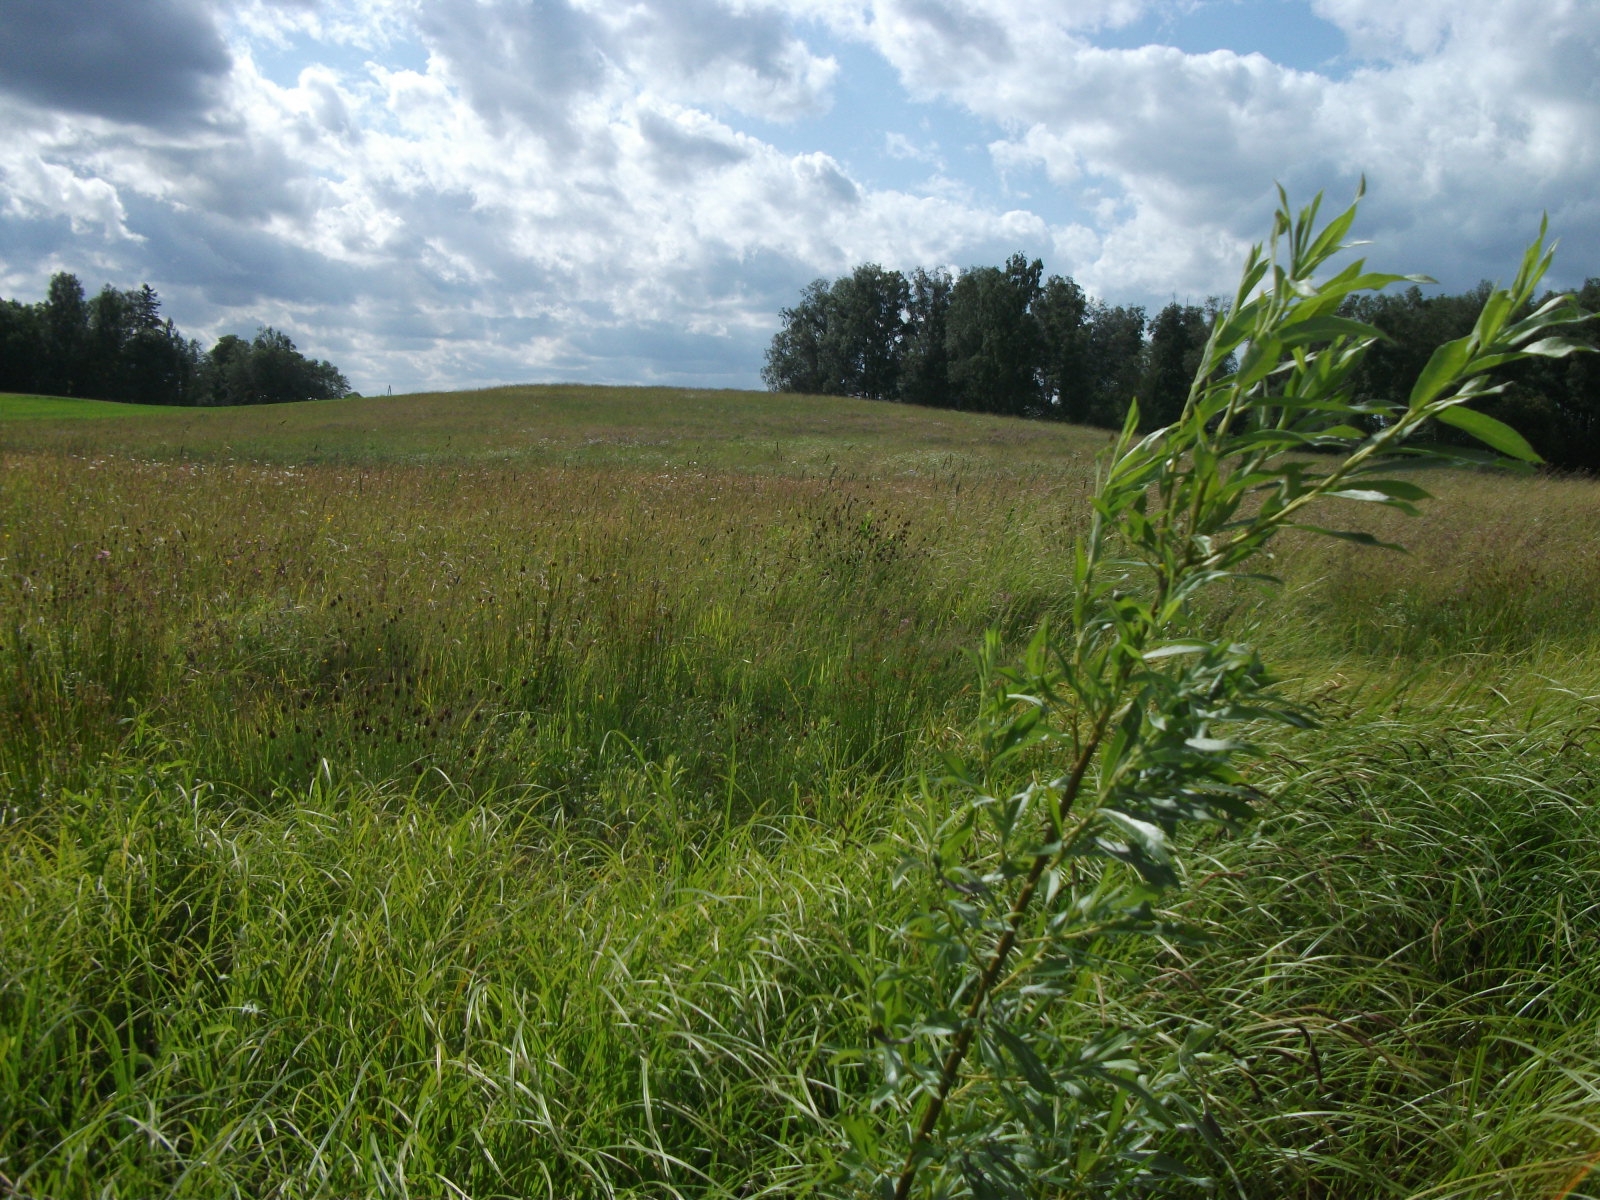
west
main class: Woodland
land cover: Broadleaved woodland
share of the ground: 50 - 75 %
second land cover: Spontaneously vegetated surfaces
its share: 50 - 75 %
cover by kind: broadleaved forest trees 50 %, shrubs 30 %, herbaceous plants 20 %
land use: Agriculture (excluding fallow land and kitchen gardens)
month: July
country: LV
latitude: 57.1650
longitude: 25.9539
